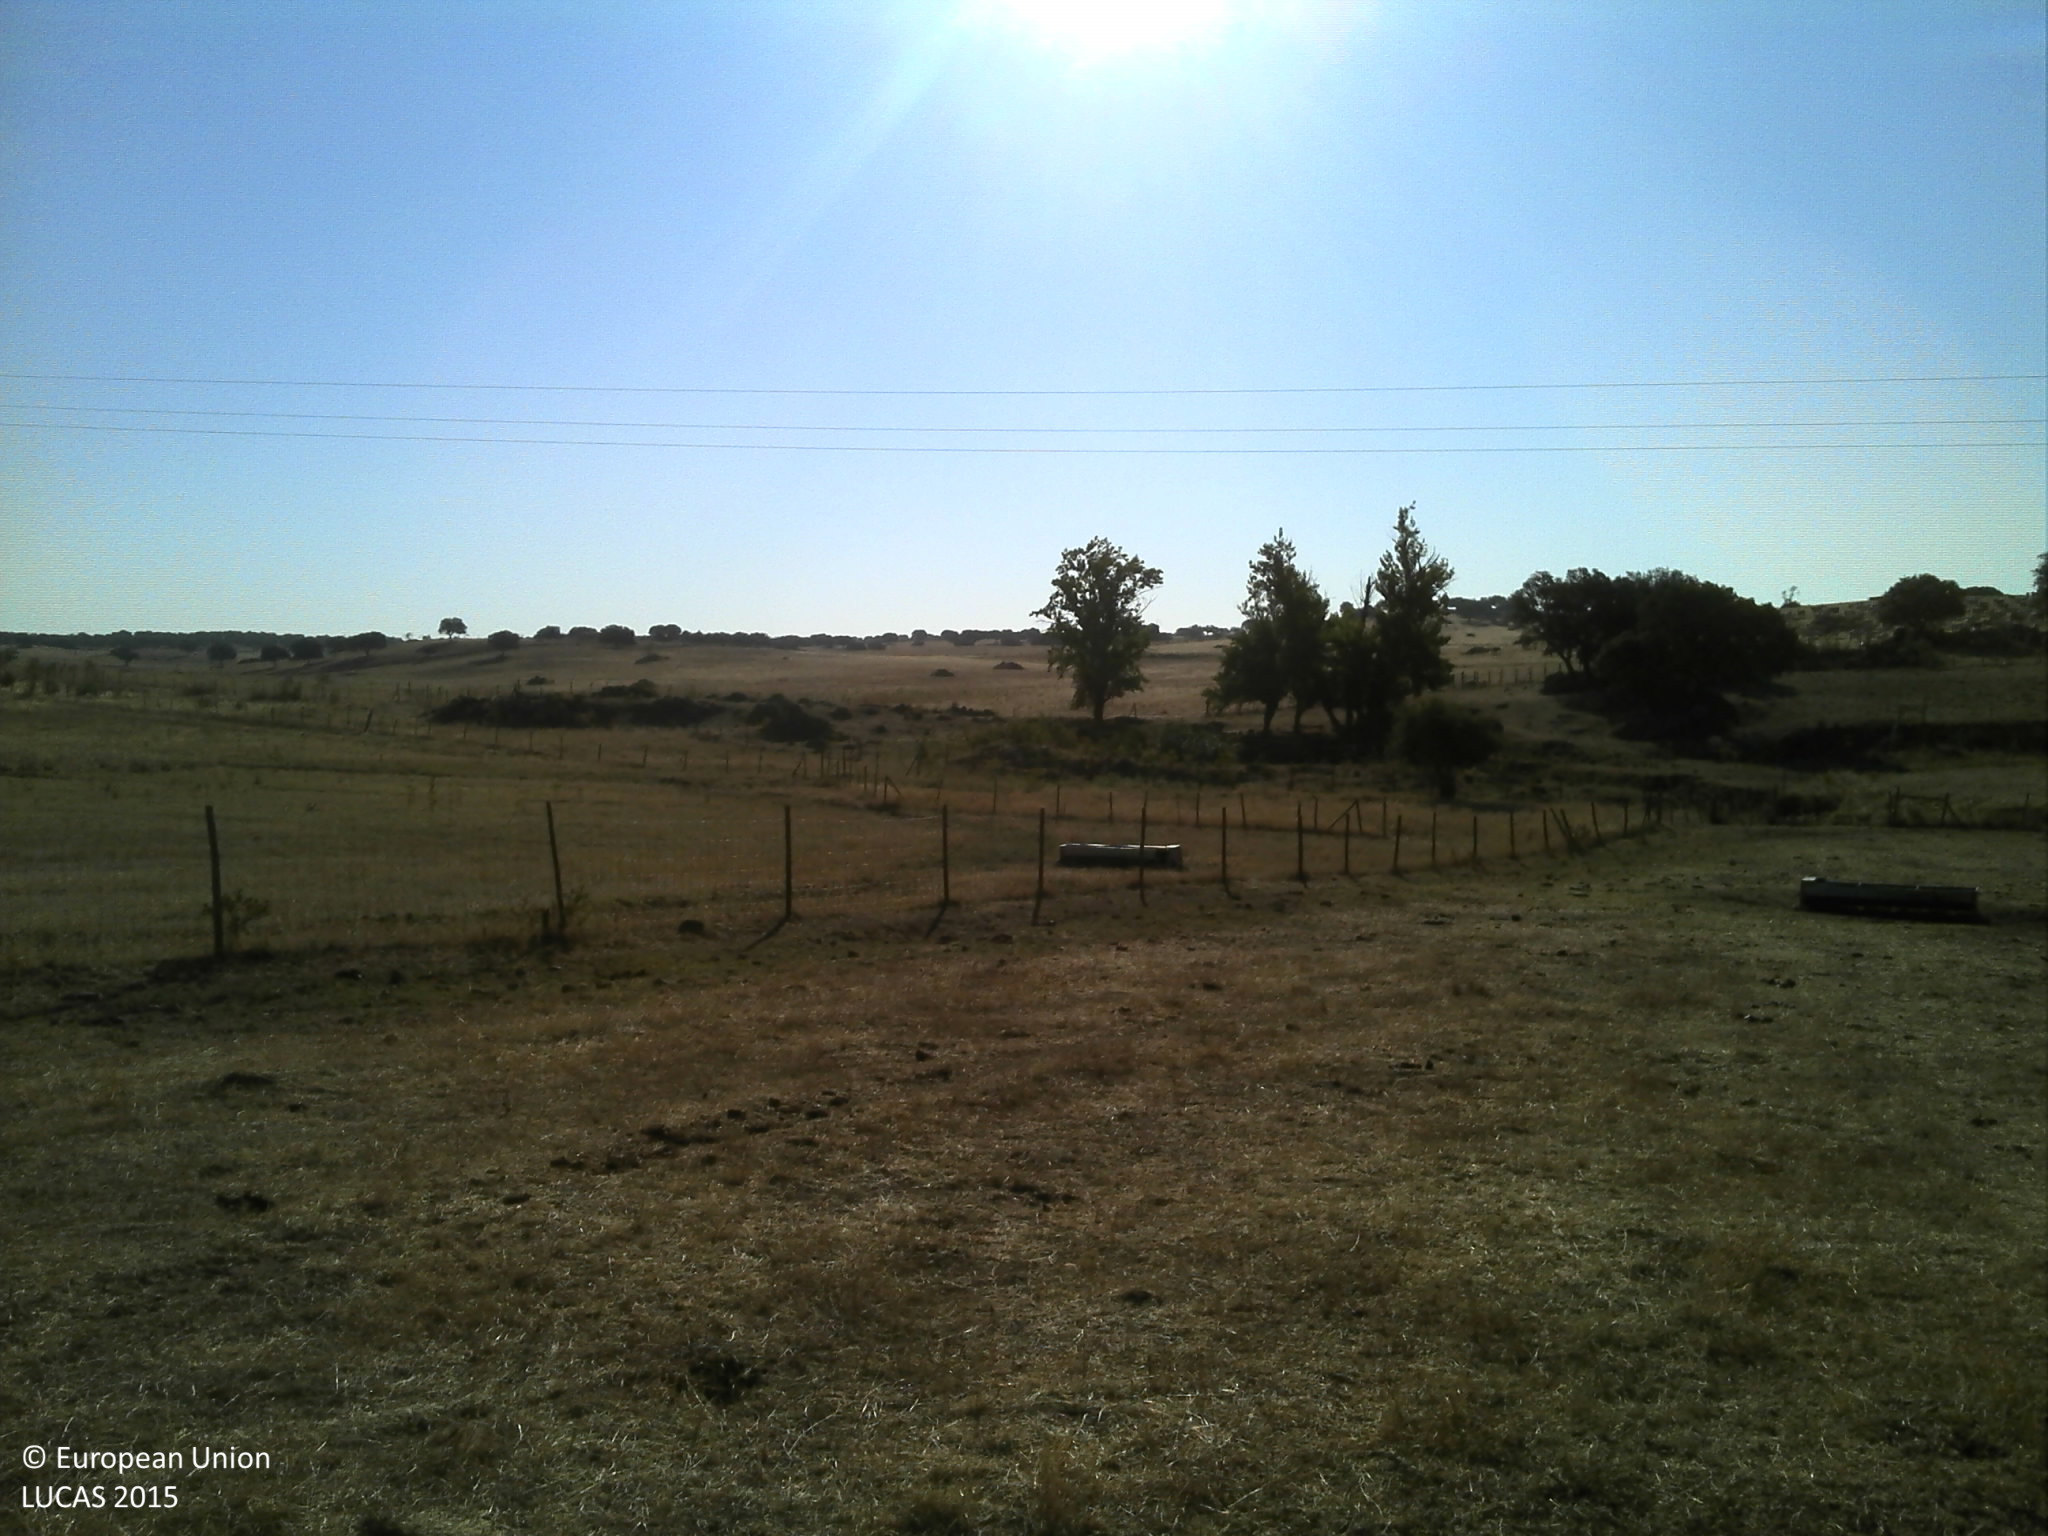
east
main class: Grassland
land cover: Grassland without tree/shrub cover
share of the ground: 10 - 25 %
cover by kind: unconsolidated bare surface 90 %, herbaceous plants 10 %
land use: Agriculture (excluding fallow land and kitchen gardens)
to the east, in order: Grassland without tree/shrub cover; Fences; Grassland without tree/shrub cover; Fences; Grassland without tree/shrub cover; Electric lines; Grassland without tree/shrub cover; Fences; Rivers and streams; Grassland without tree/shrub cover; Inland fresh water bodies; Grassland without tree/shrub cover; Rivers and streams; Broadleaved woodland; Grassland without tree/shrub cover; Fences; Grassland without tree/shrub cover
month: July
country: PT
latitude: 38.9922
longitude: -7.4115
